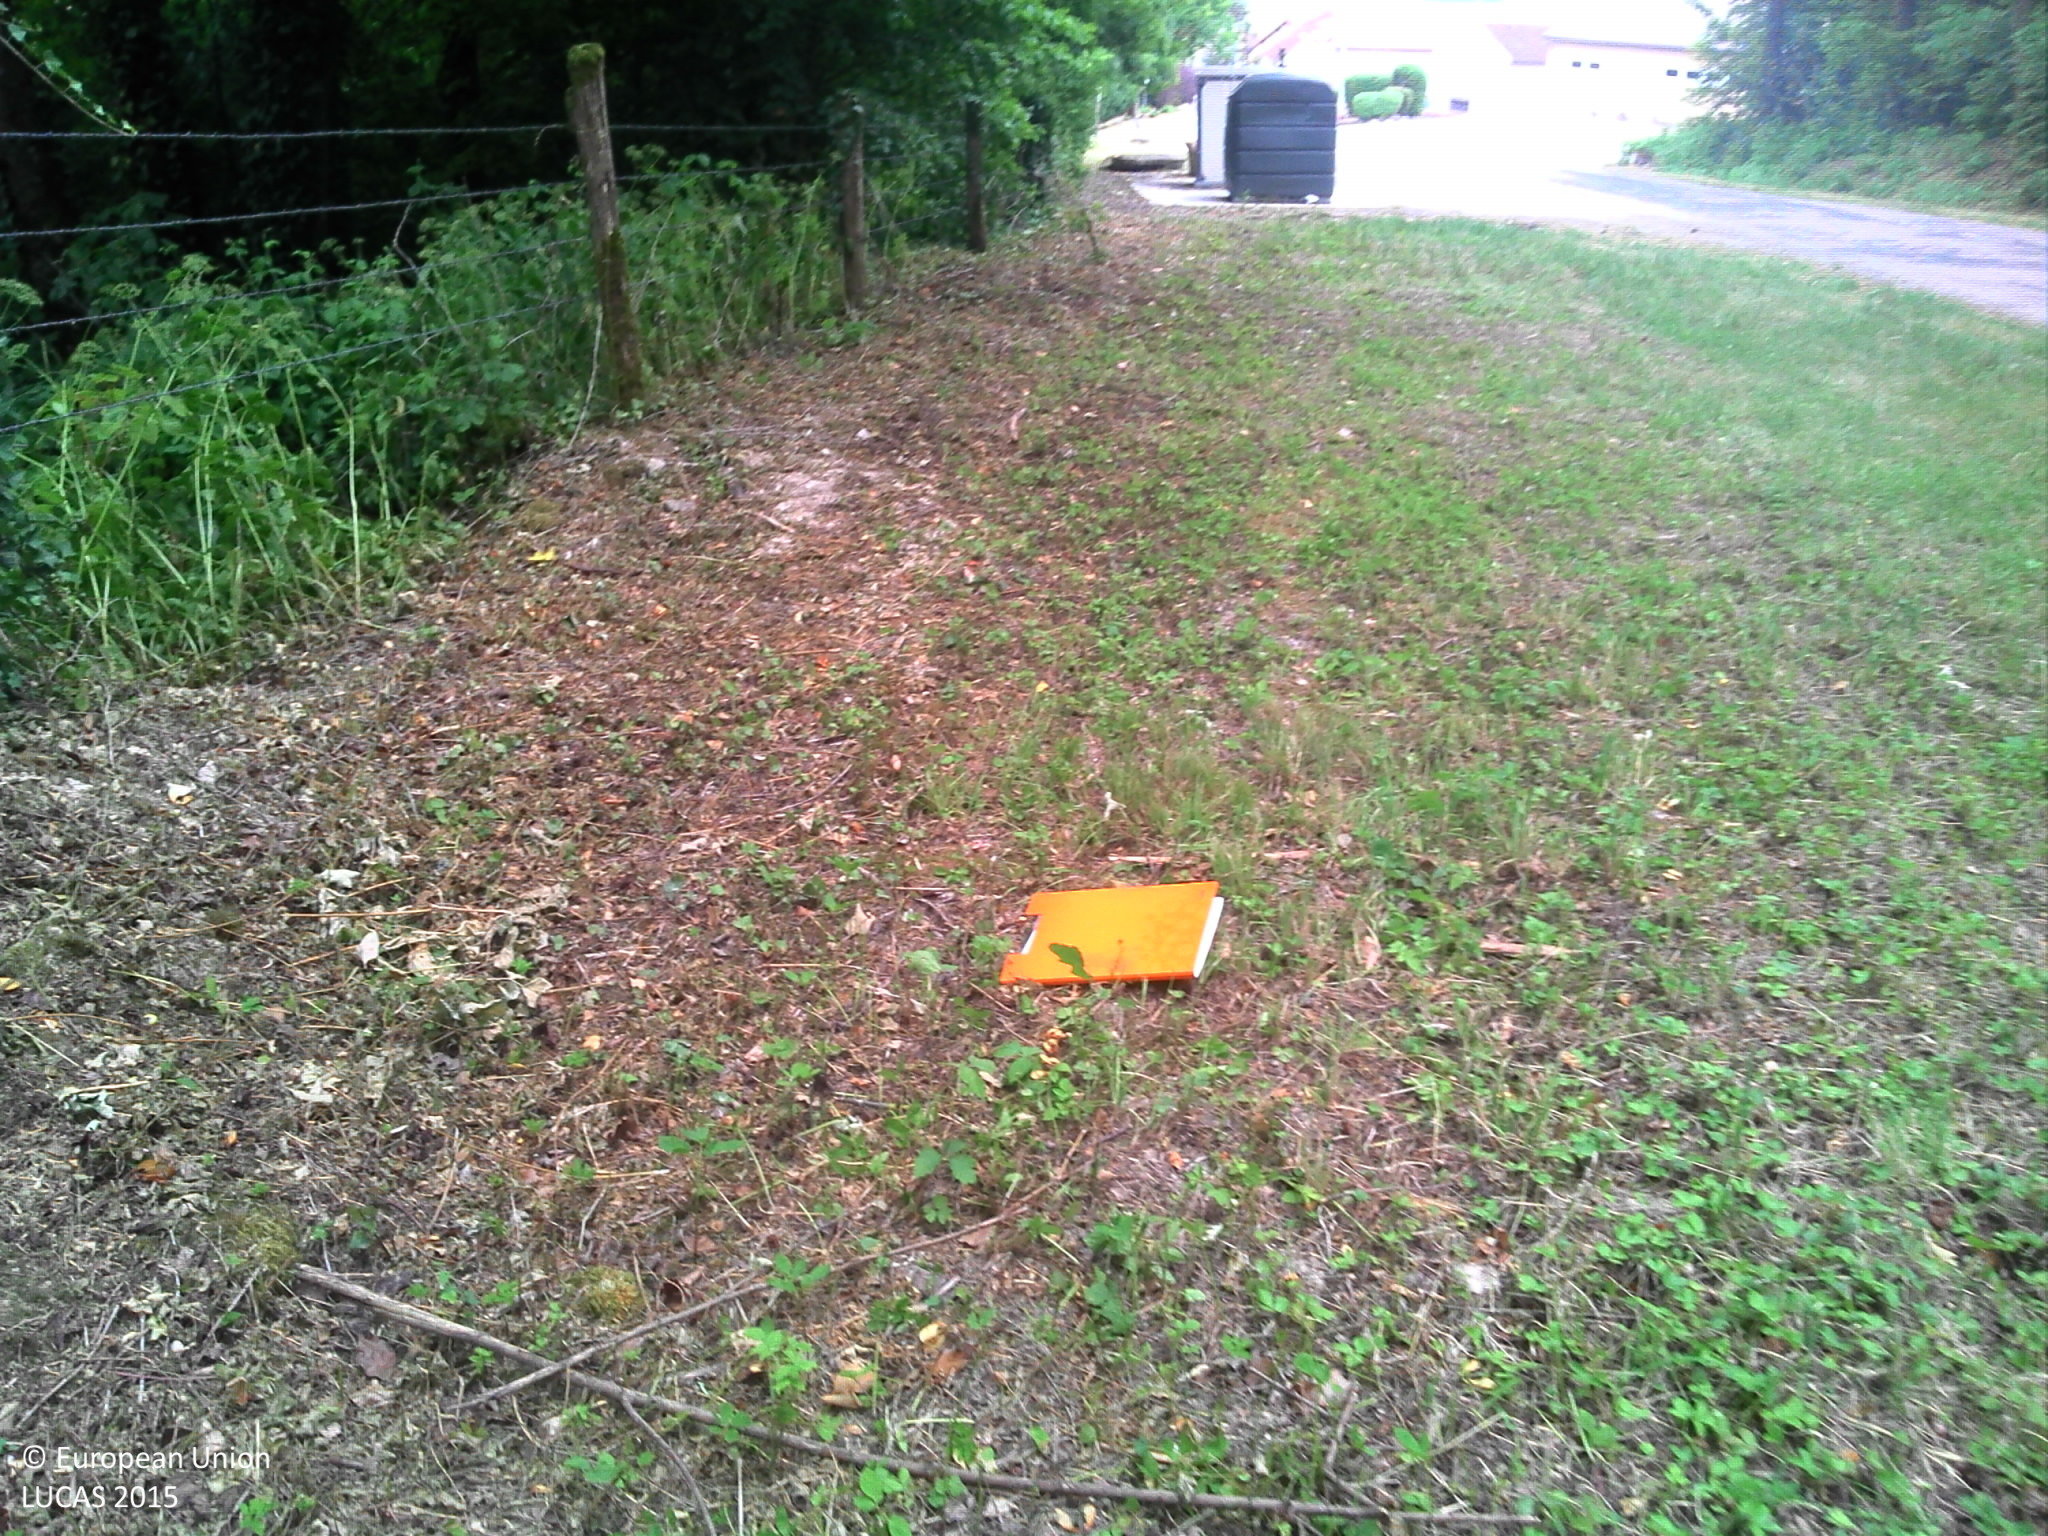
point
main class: Grassland
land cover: Grassland without tree/shrub cover
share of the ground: > 75 %
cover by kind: herbaceous plants 100 %
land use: Semi-natural and natural areas not in use
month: July
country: FR
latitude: 48.1300
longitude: 5.0410
